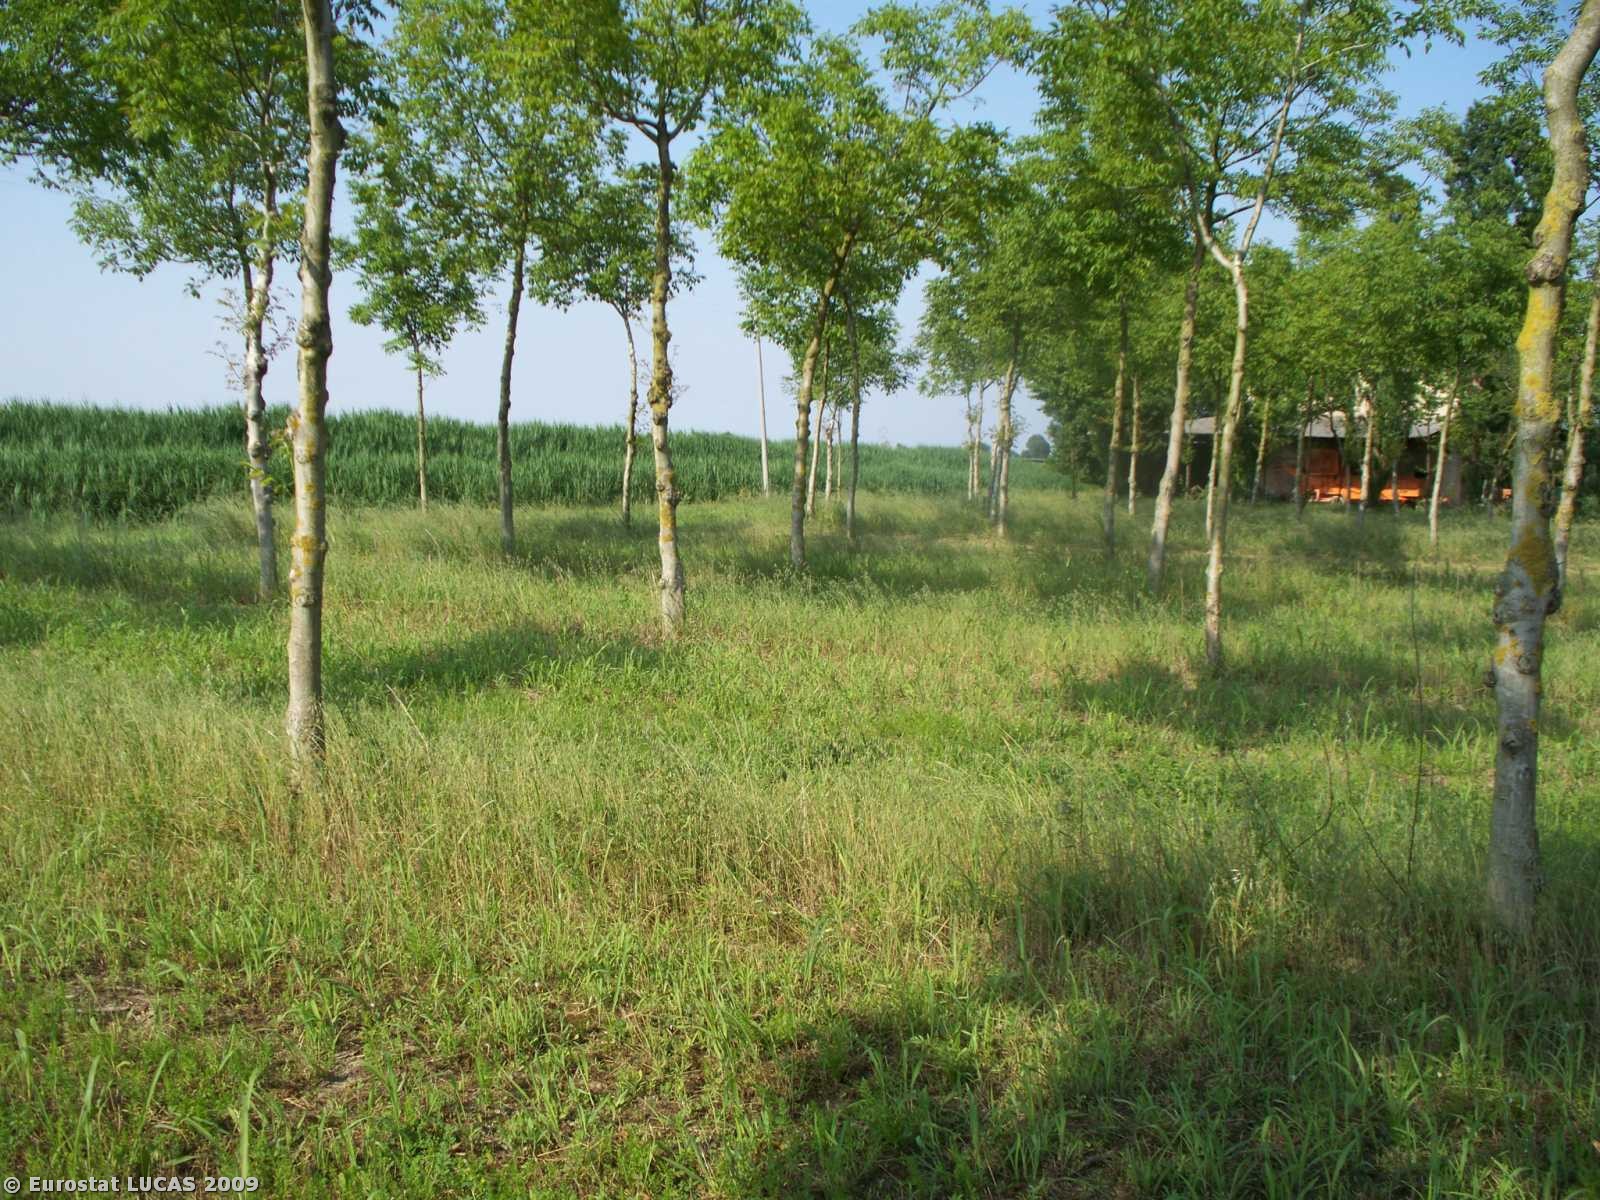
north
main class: Cropland
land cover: Nuts trees
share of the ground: 10 - 25 %
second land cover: Grassland with sparse tree/shrub cover
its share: > 75 %
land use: Agriculture (excluding fallow land and kitchen gardens)
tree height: > 5 m
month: May
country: IT
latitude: 45.3212
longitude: 12.1015
